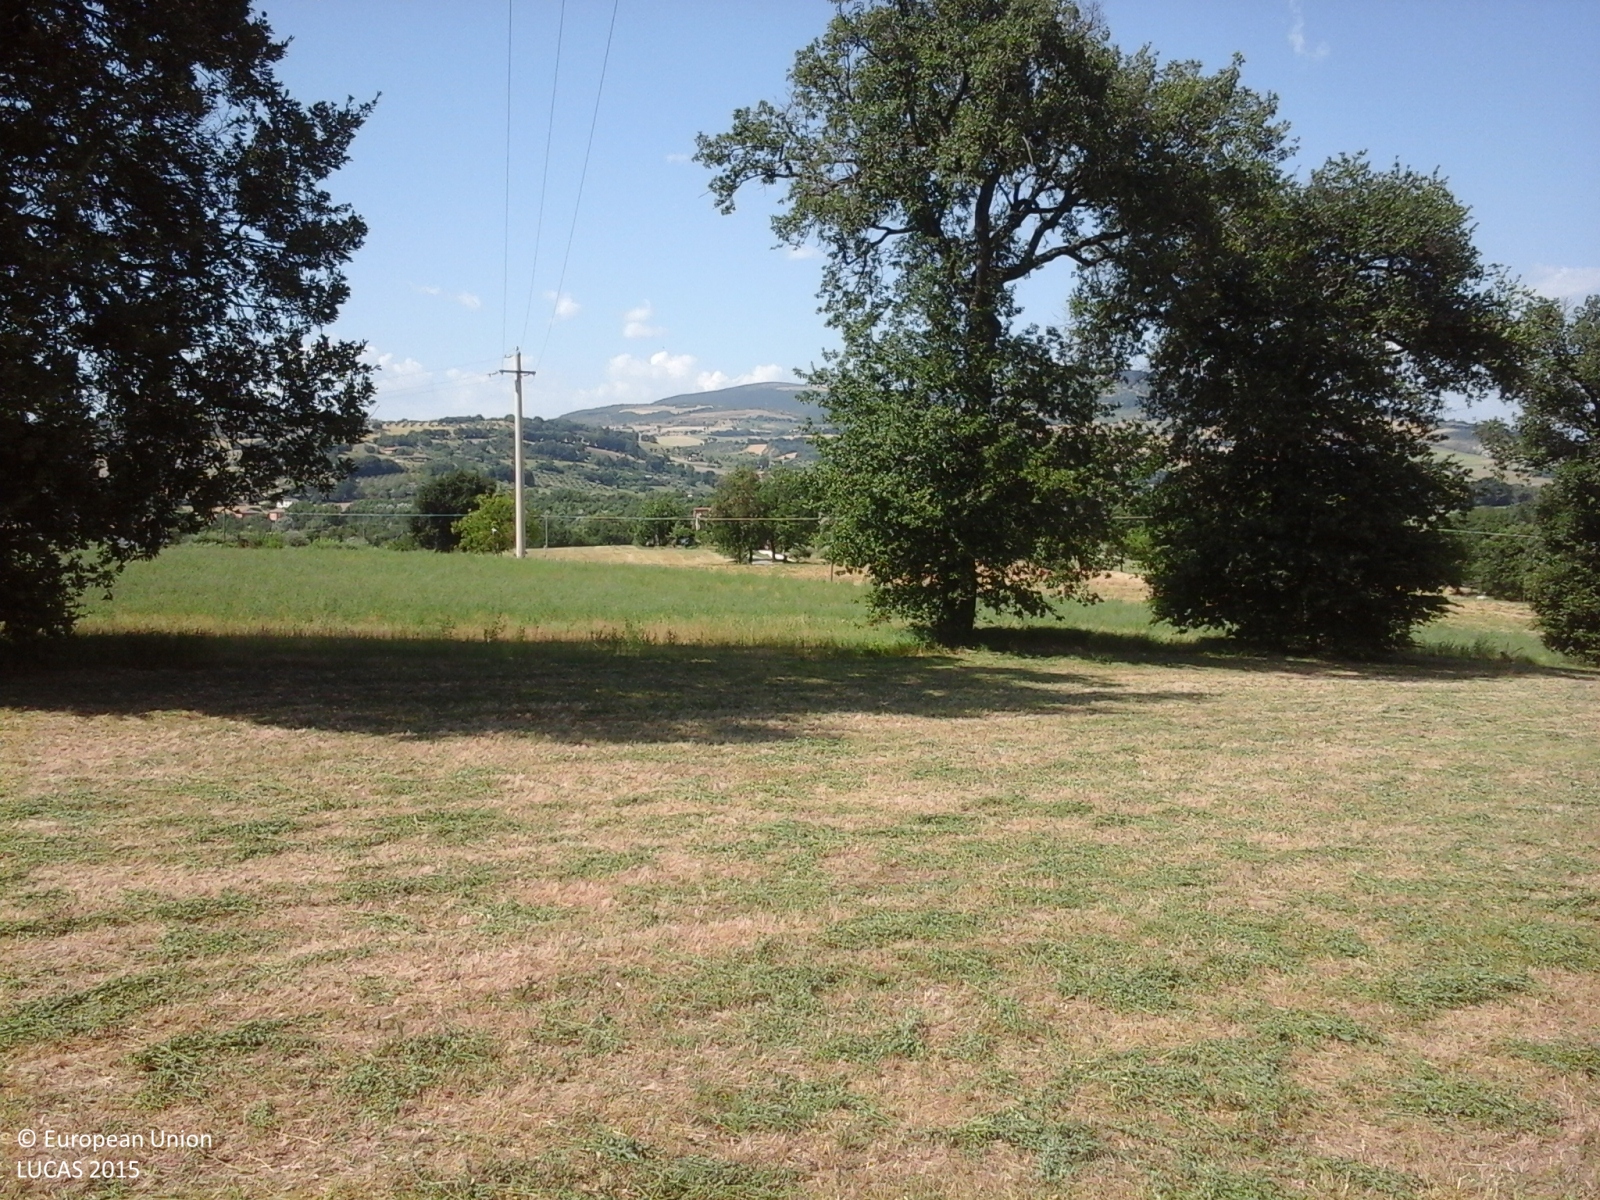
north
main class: Cropland
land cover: Lucerne
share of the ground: > 75 %
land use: Agriculture (excluding fallow land and kitchen gardens)
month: July
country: IT
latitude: 43.2350
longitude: 13.2299
